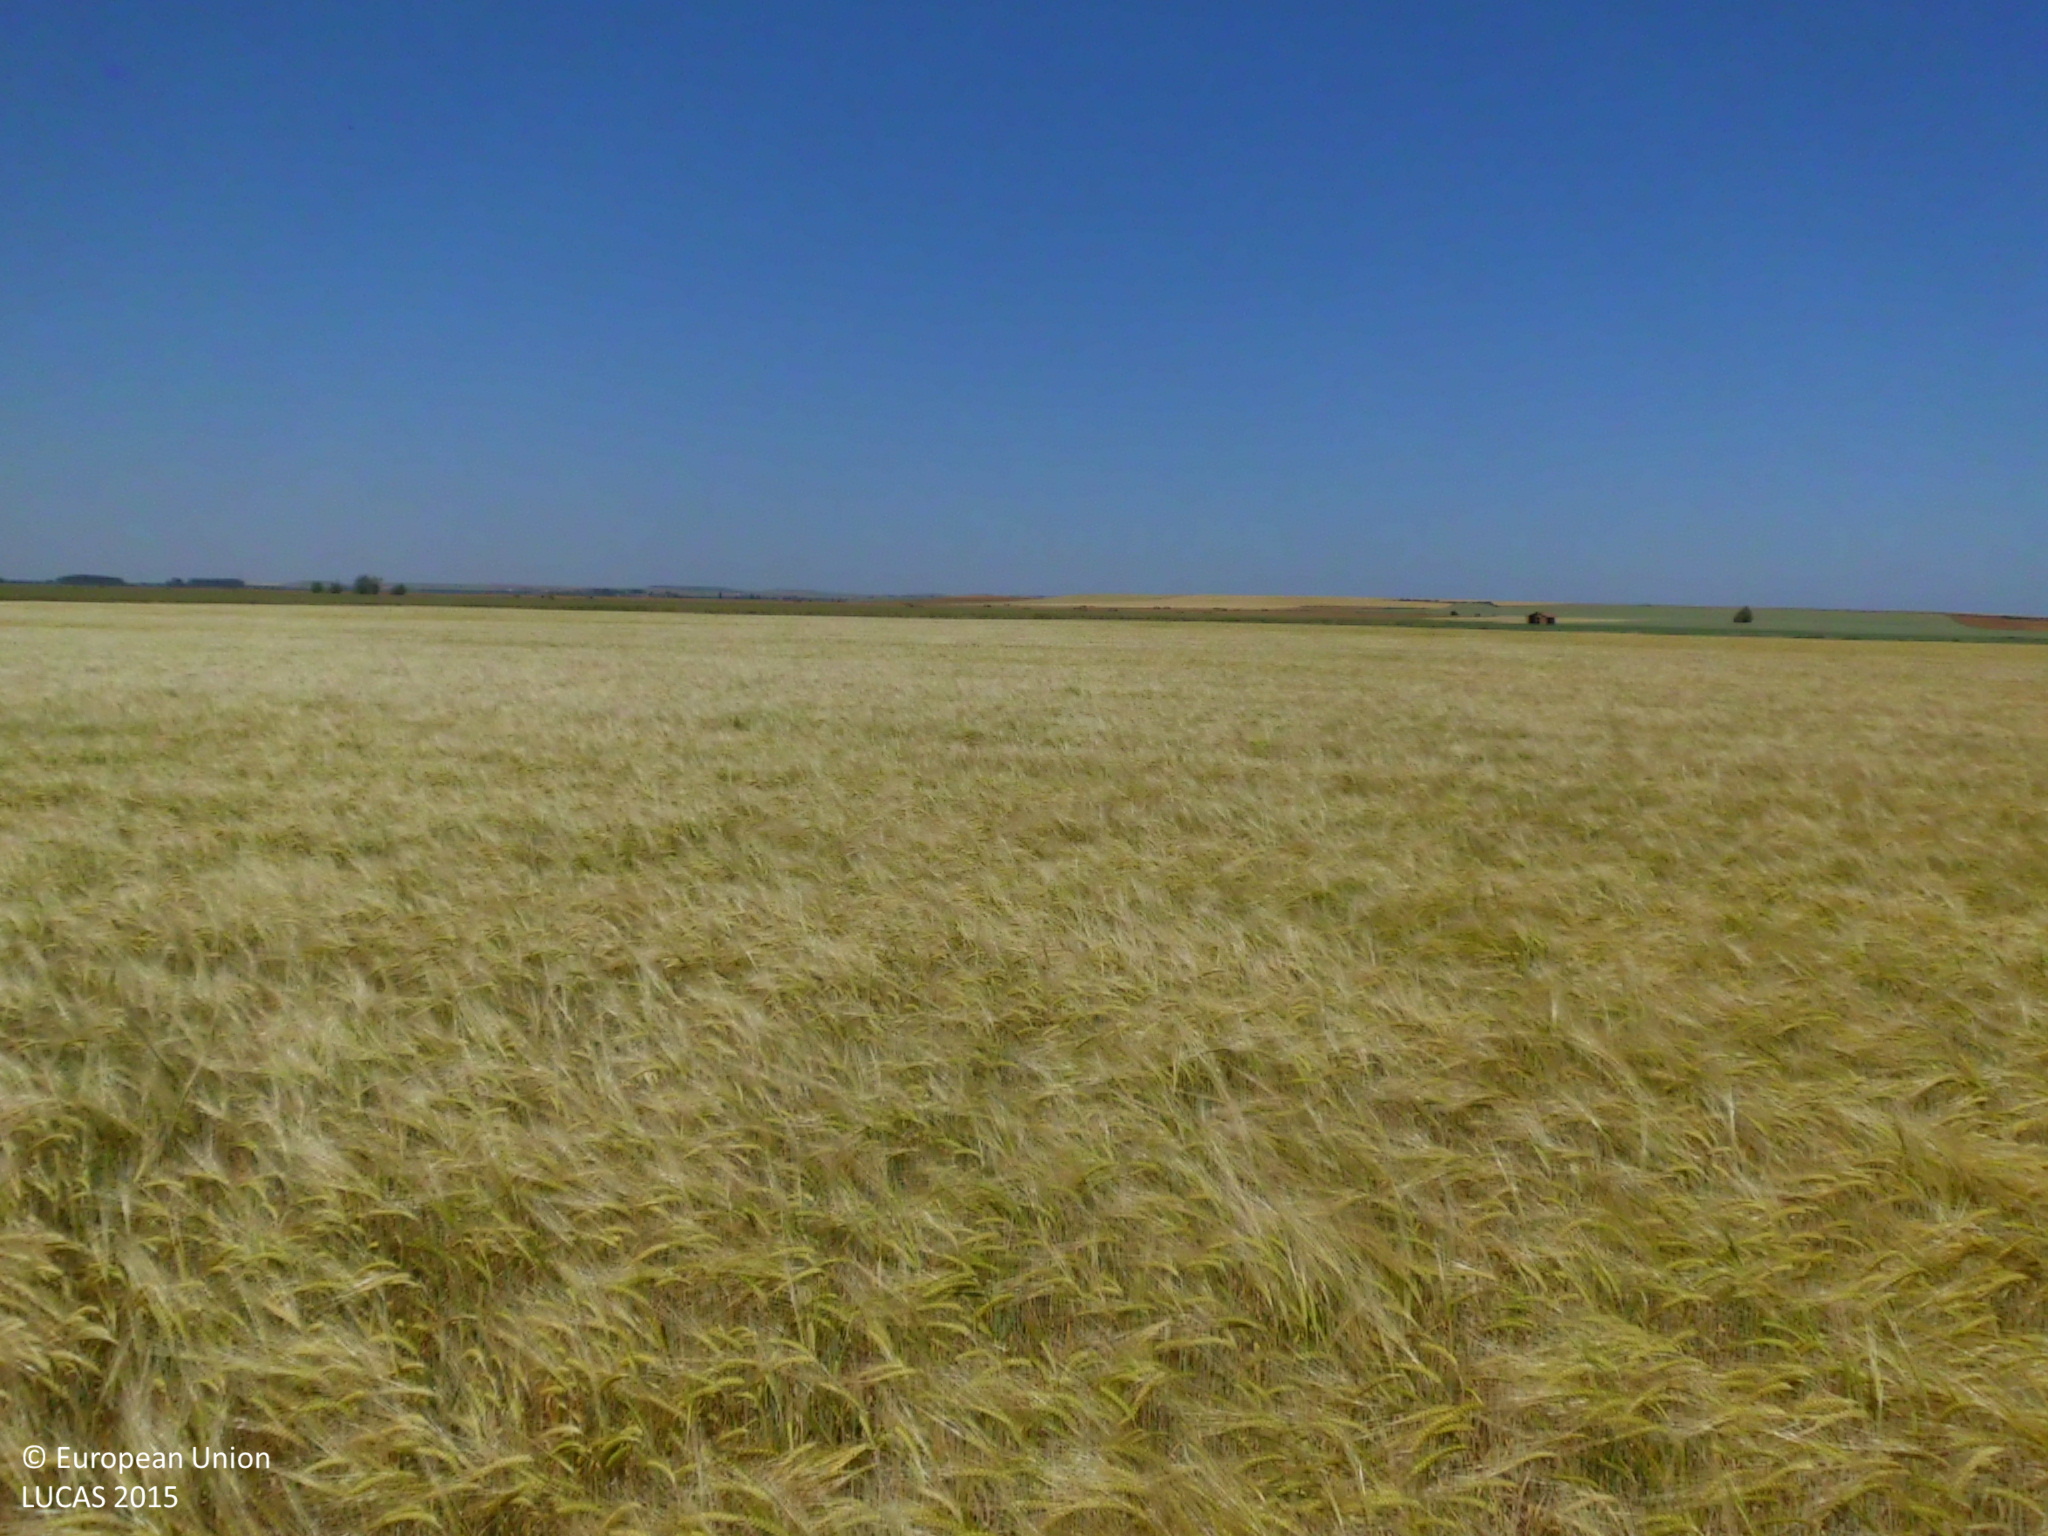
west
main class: Cropland
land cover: Barley
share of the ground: > 75 %
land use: Agriculture (excluding fallow land and kitchen gardens)
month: June
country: ES
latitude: 42.3809
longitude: -4.1940
